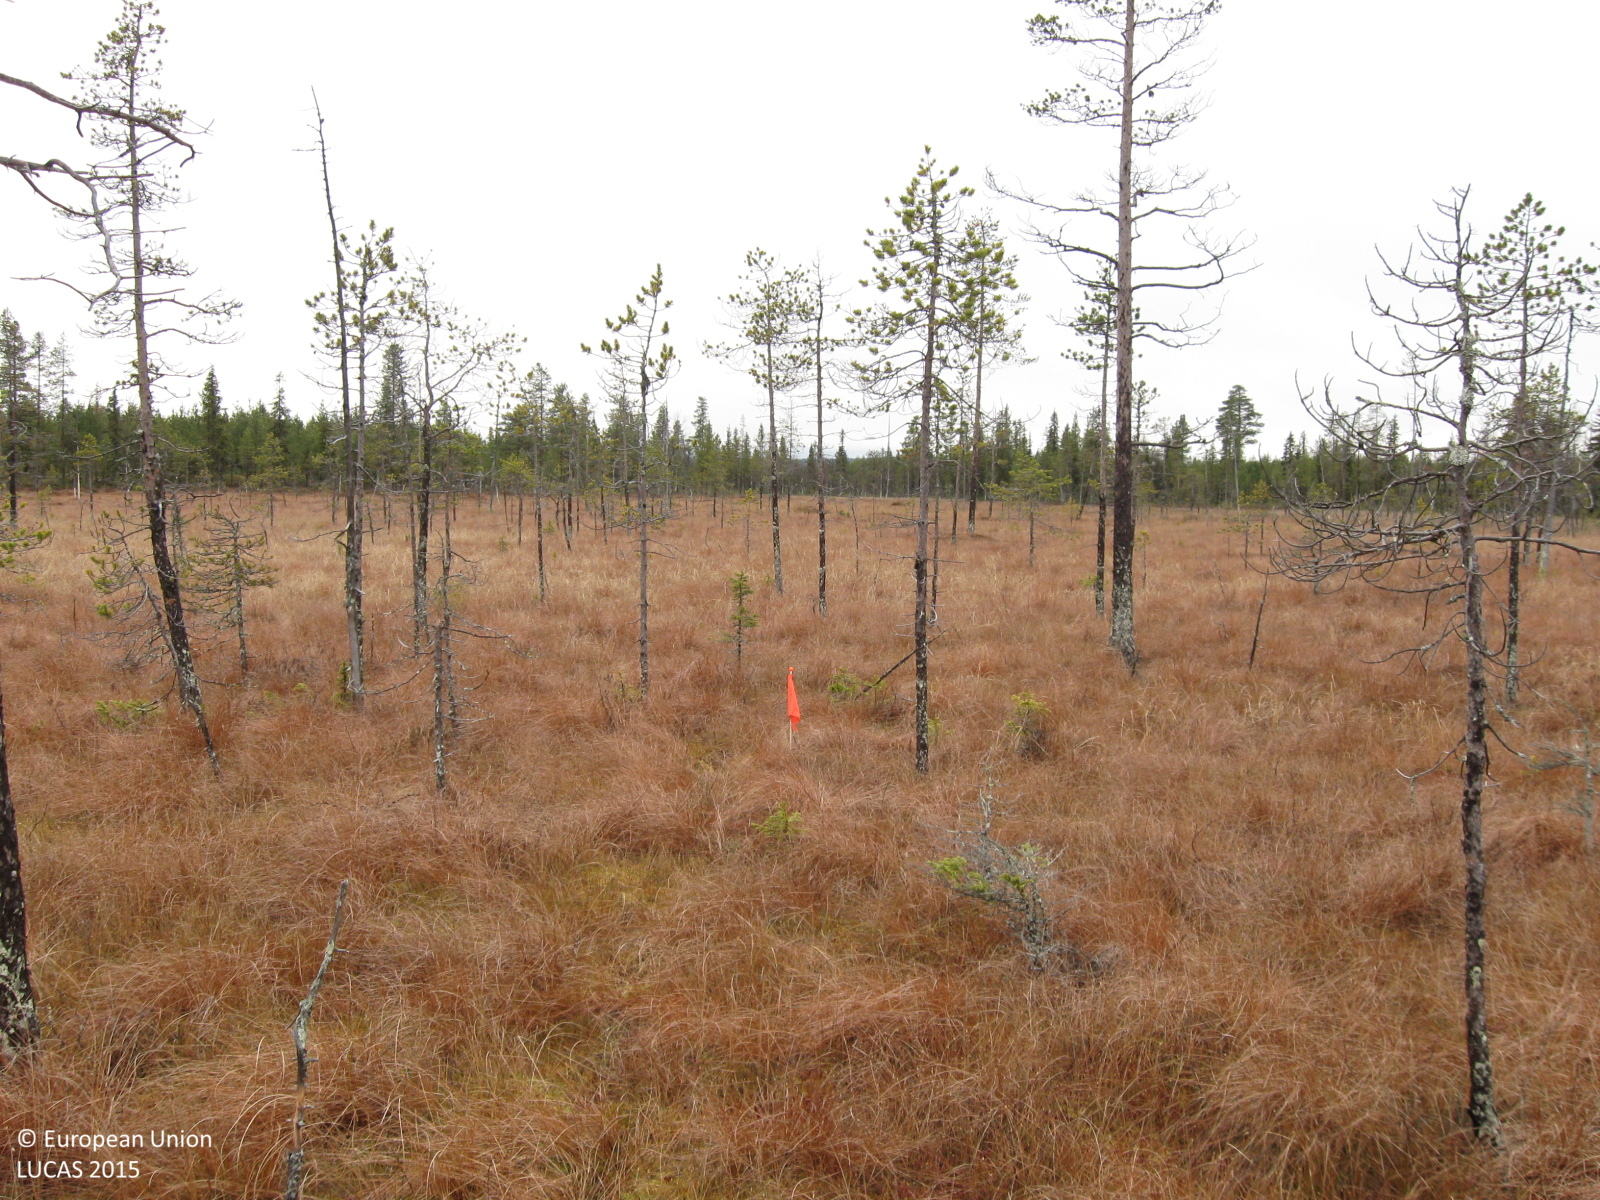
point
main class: Woodland
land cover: Pine dominated coniferous woodland
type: mire and swamp forests
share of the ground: 25 - 50 %
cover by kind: herbaceous plants 60 %, coniferous forest trees 25 %, lichens and mosses 10 %, shrubs 5 %
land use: Semi-natural and natural areas not in use
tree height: < 5 m
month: October
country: SE
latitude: 66.6479
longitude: 21.8326
